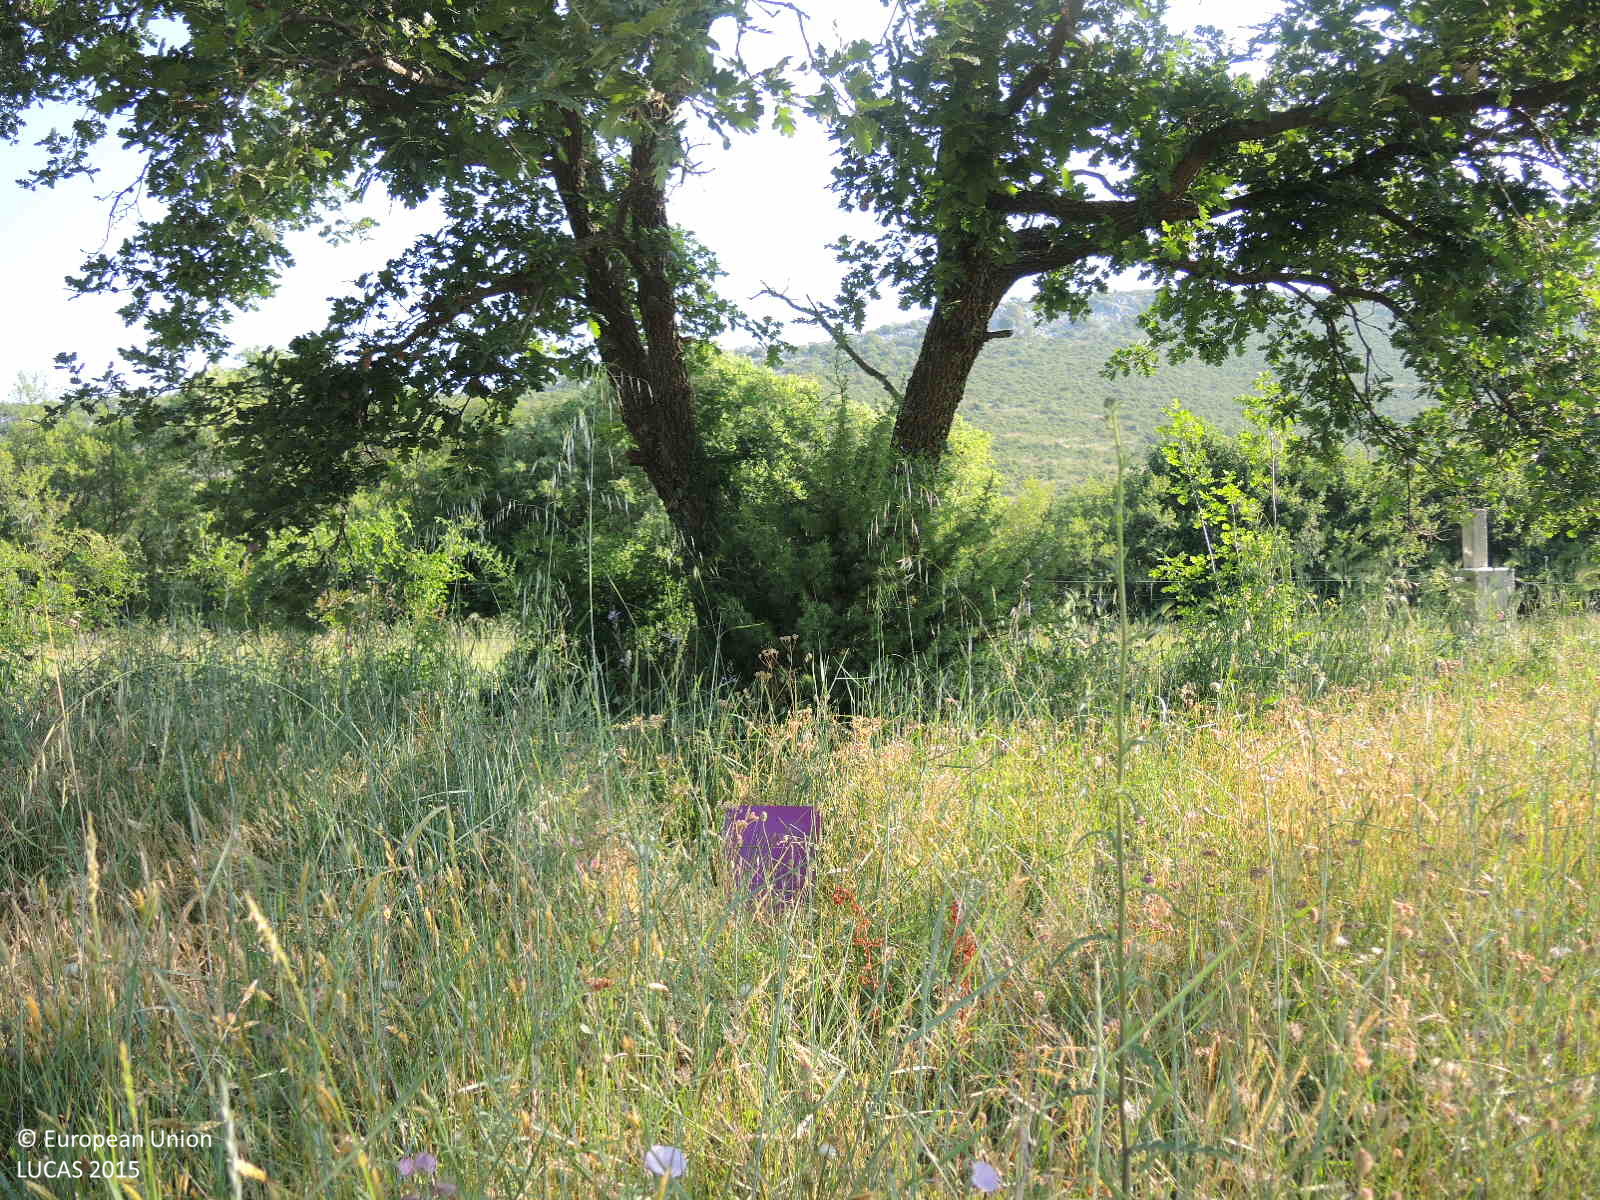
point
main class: Grassland
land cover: Grassland with sparse tree/shrub cover
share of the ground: 10 - 25 %
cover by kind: herbaceous plants 85 %, broadleaved forest trees 5 %, shrubs 5 %, unconsolidated bare surface 5 %
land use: Abandoned areas
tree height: < 5 m
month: June
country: HR
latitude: 43.6045
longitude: 16.1977
